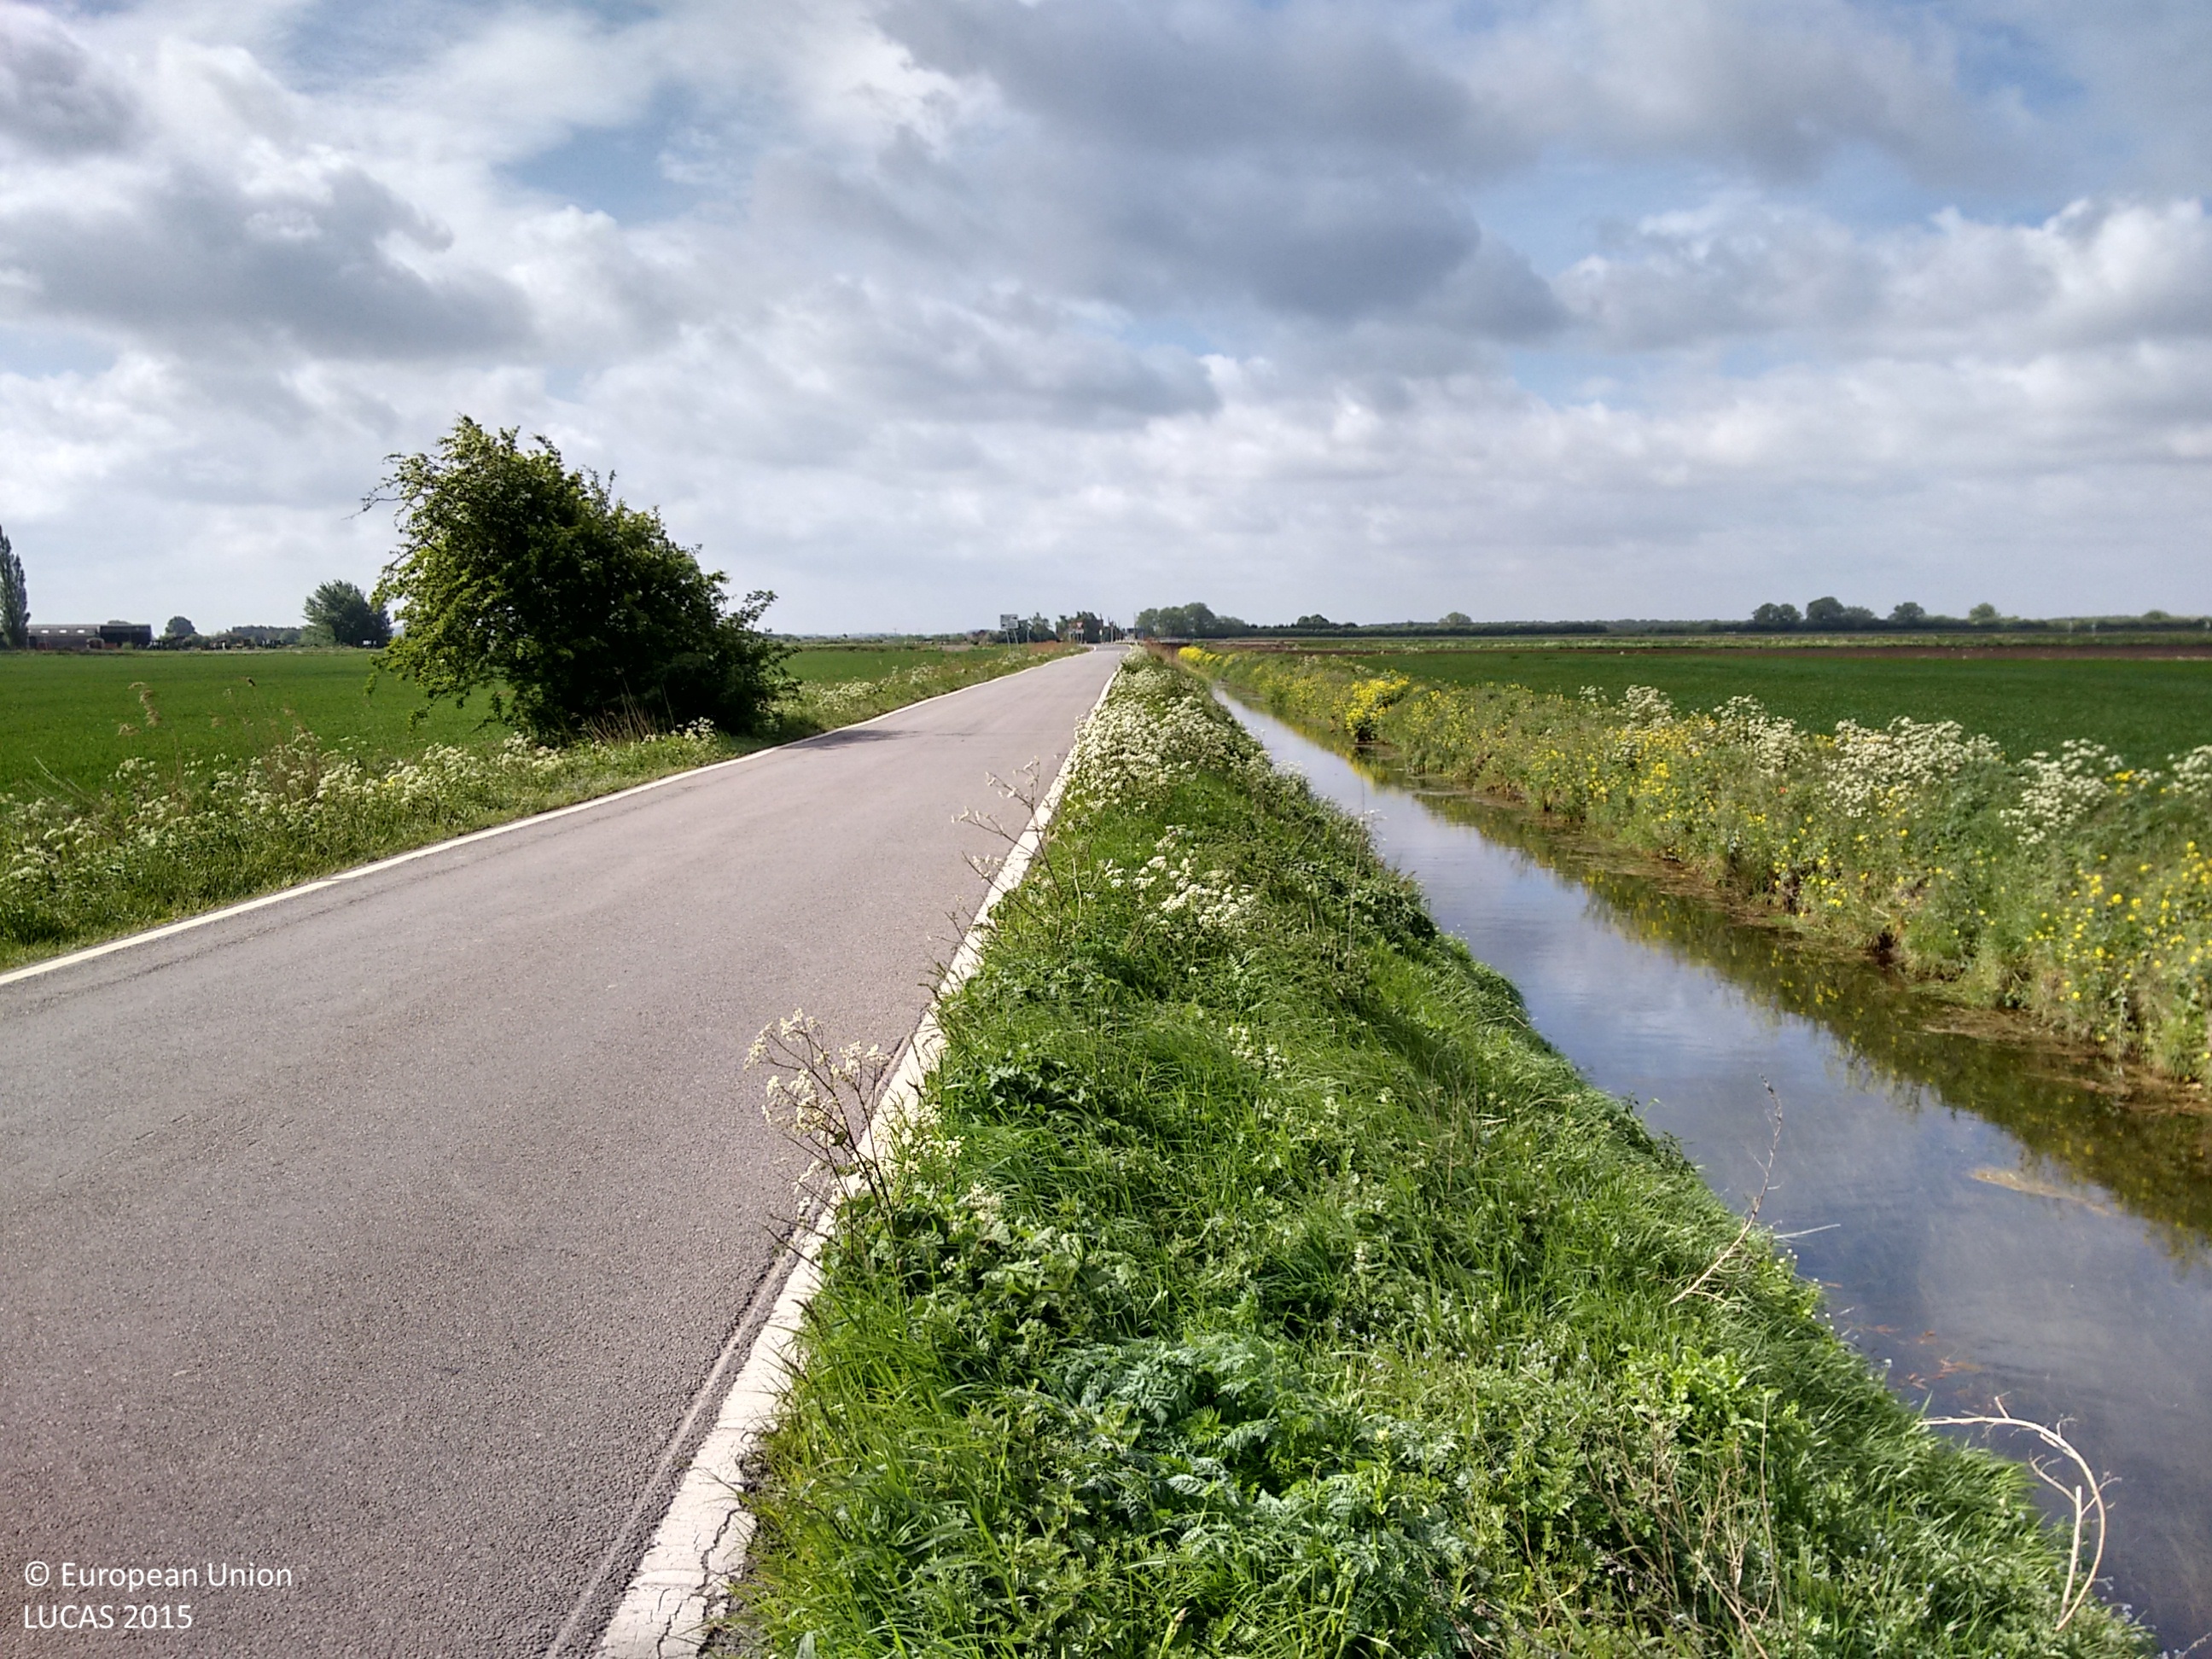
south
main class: Cropland
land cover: Permanent crops (only in case pi)
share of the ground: > 75 %
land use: Agriculture (excluding fallow land and kitchen gardens)
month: May
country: GB
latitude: 53.4883
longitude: -0.9086
